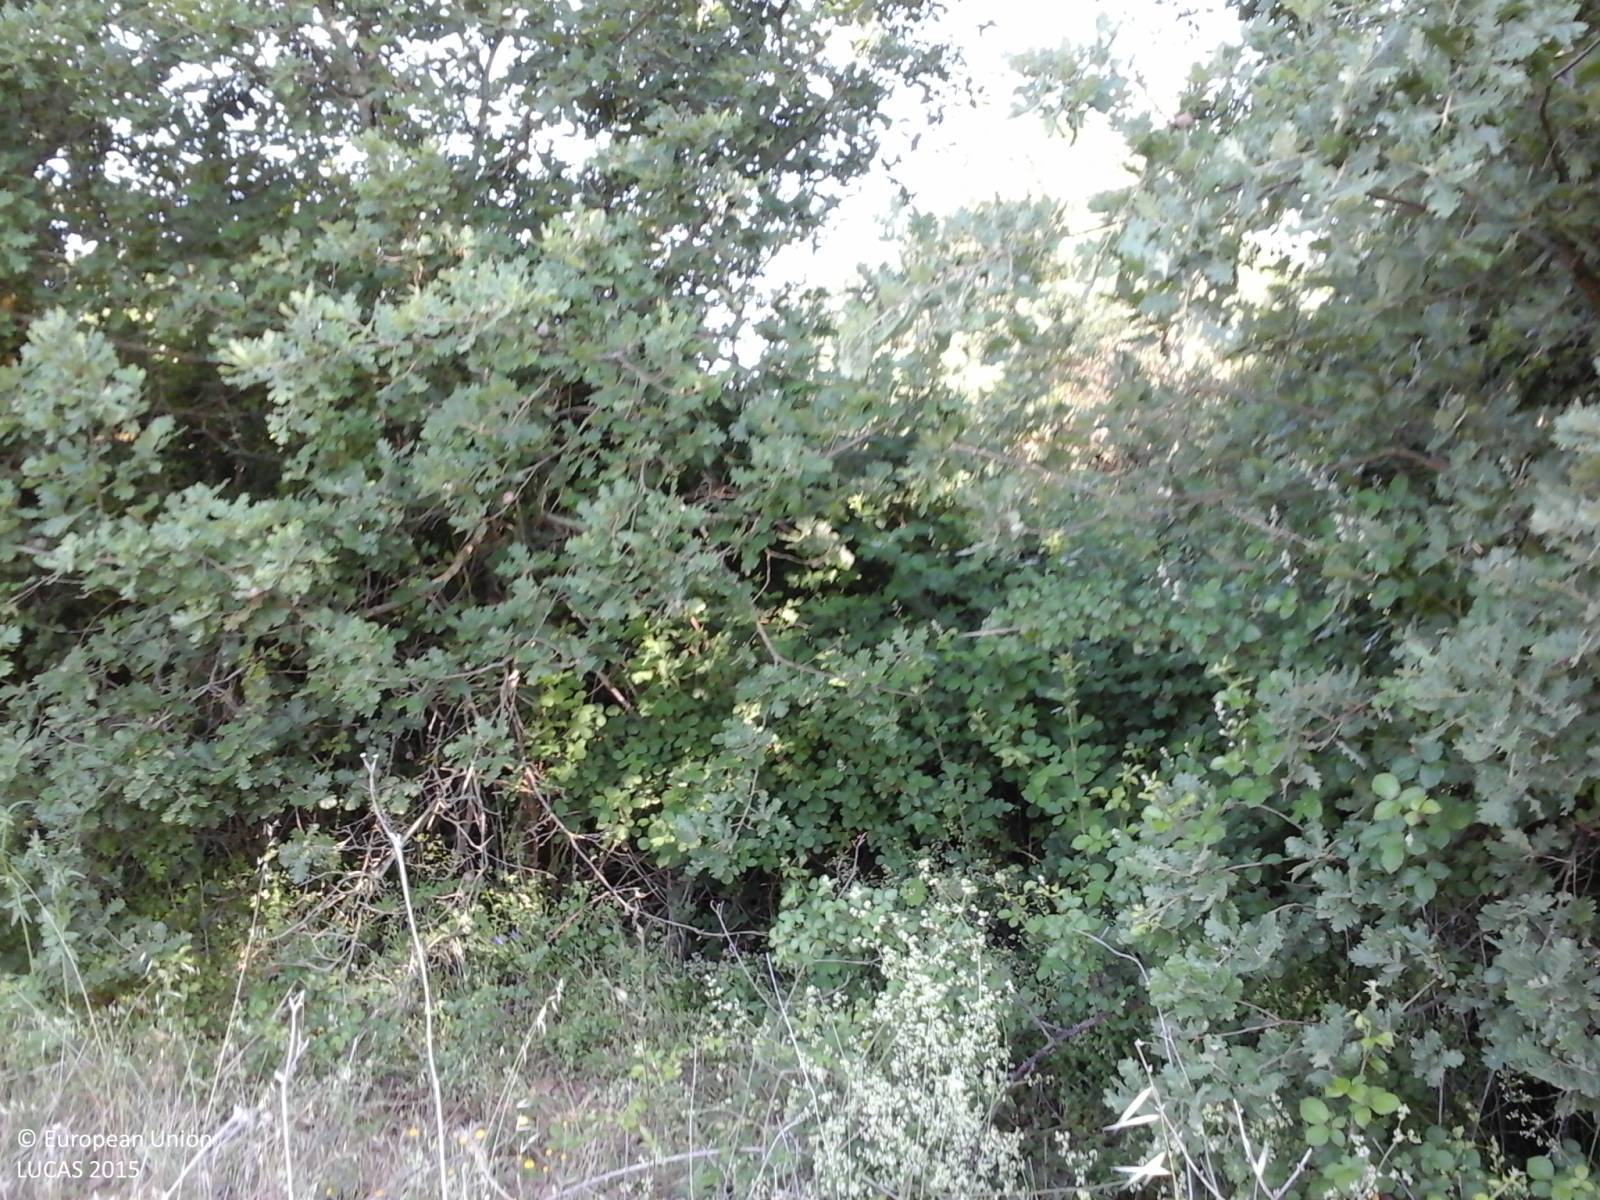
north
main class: Woodland
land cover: Broadleaved woodland
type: thermophilous deciduous forest
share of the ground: > 75 %
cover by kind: broadleaved forest trees 90 %, shrubs 10 %
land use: Forestry
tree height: > 5 m
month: June
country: IT
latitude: 42.6151
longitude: 12.0535
